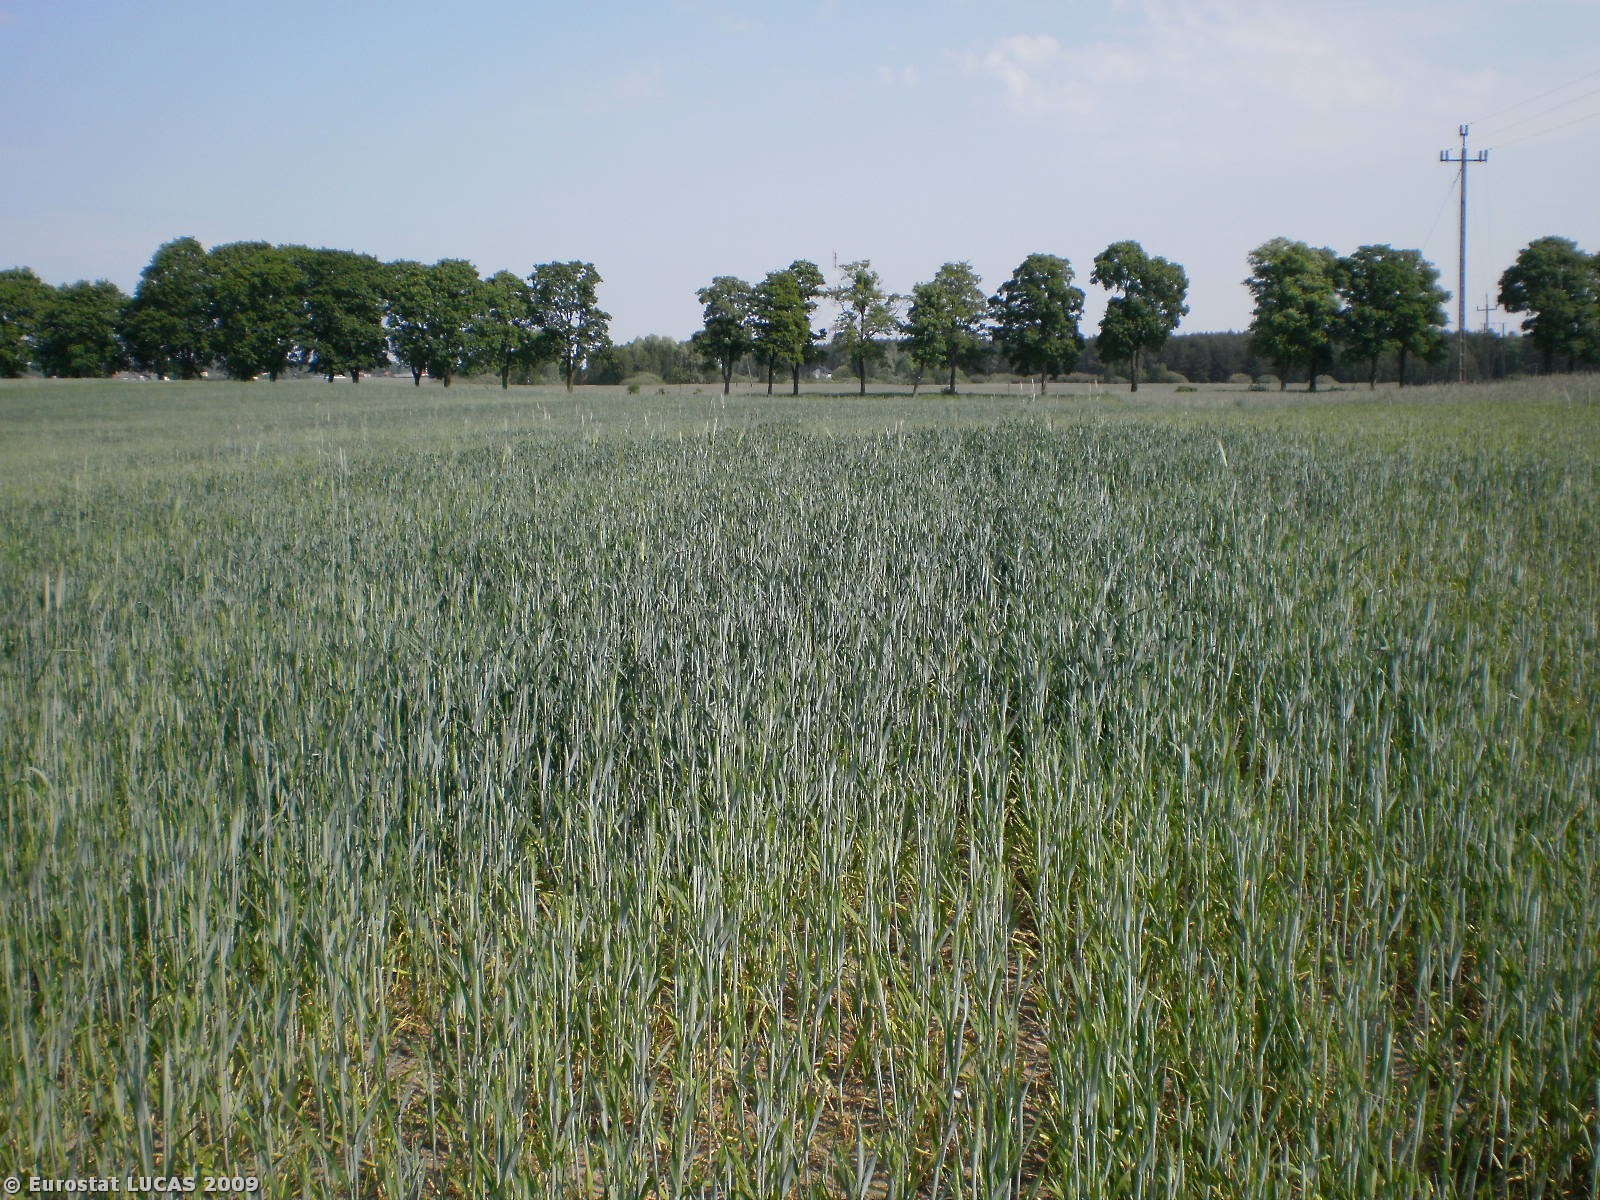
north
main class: Cropland
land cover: Triticale
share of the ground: > 75 %
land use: Agriculture (excluding fallow land and kitchen gardens)
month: May
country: PL
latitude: 53.4019
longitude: 18.0923
